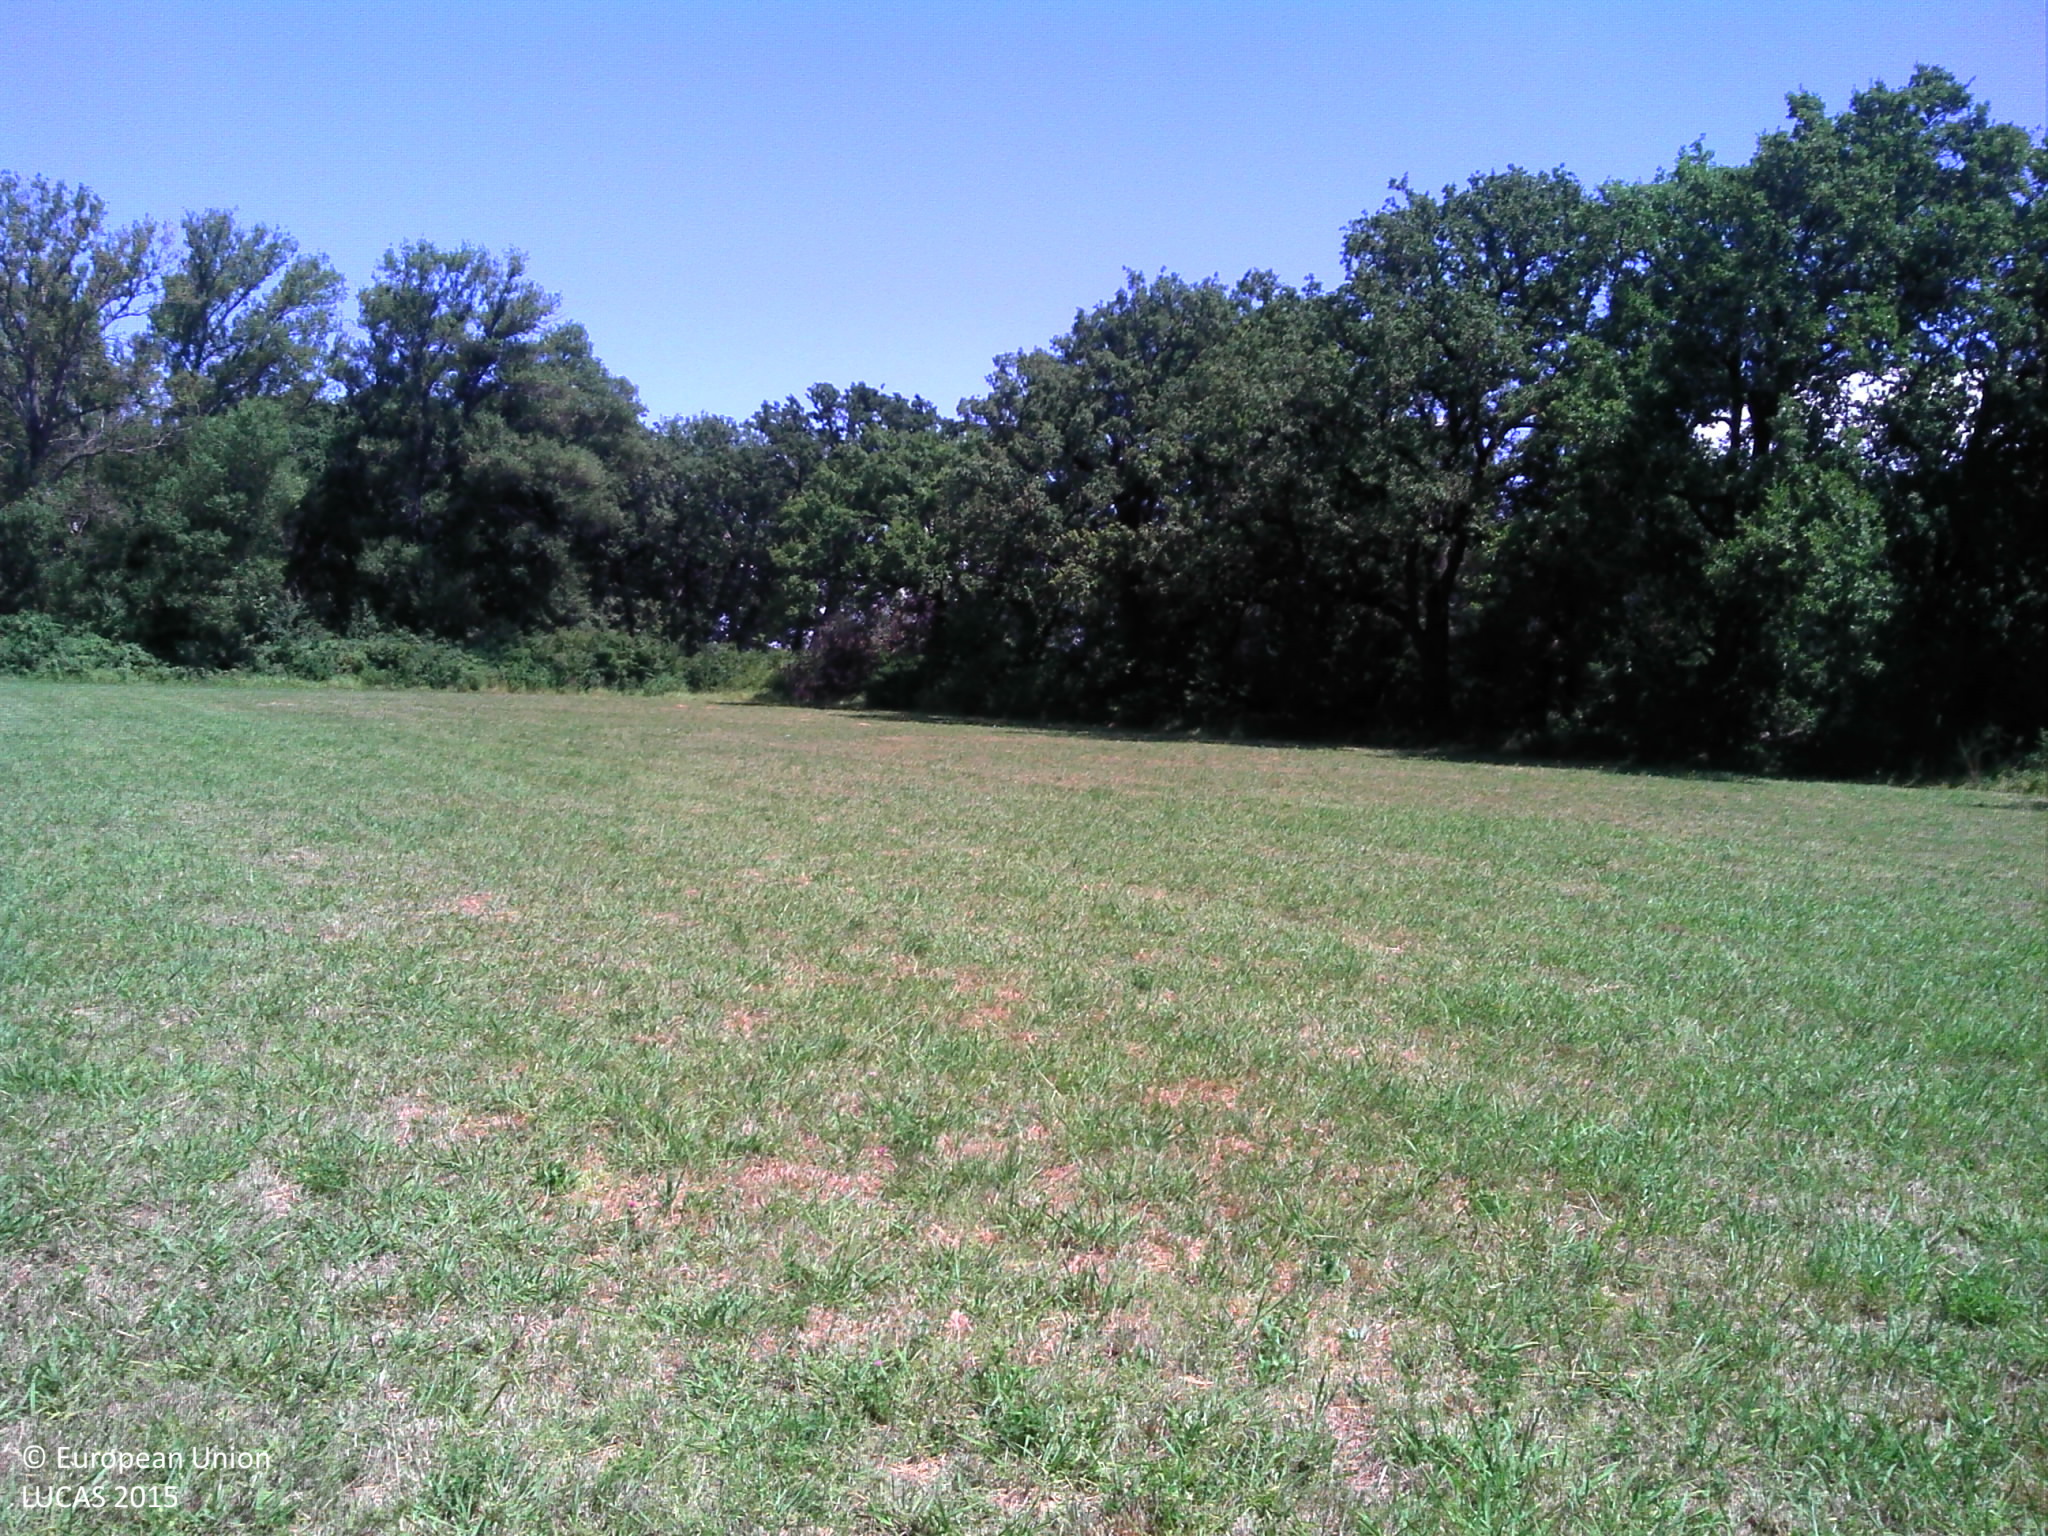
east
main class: Grassland
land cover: Grassland without tree/shrub cover
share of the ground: > 75 %
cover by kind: herbaceous plants 100 %
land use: Agriculture (excluding fallow land and kitchen gardens)
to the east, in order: Grassland without tree/shrub cover; Shruby margins; Broadleaved woodland; Ditches and canals; Tracks; Grass margins; Grassland without tree/shrub cover; Shruby margins; Ditches and canals; Broadleaved woodland
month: July
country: FR
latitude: 43.5706
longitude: 4.8218
